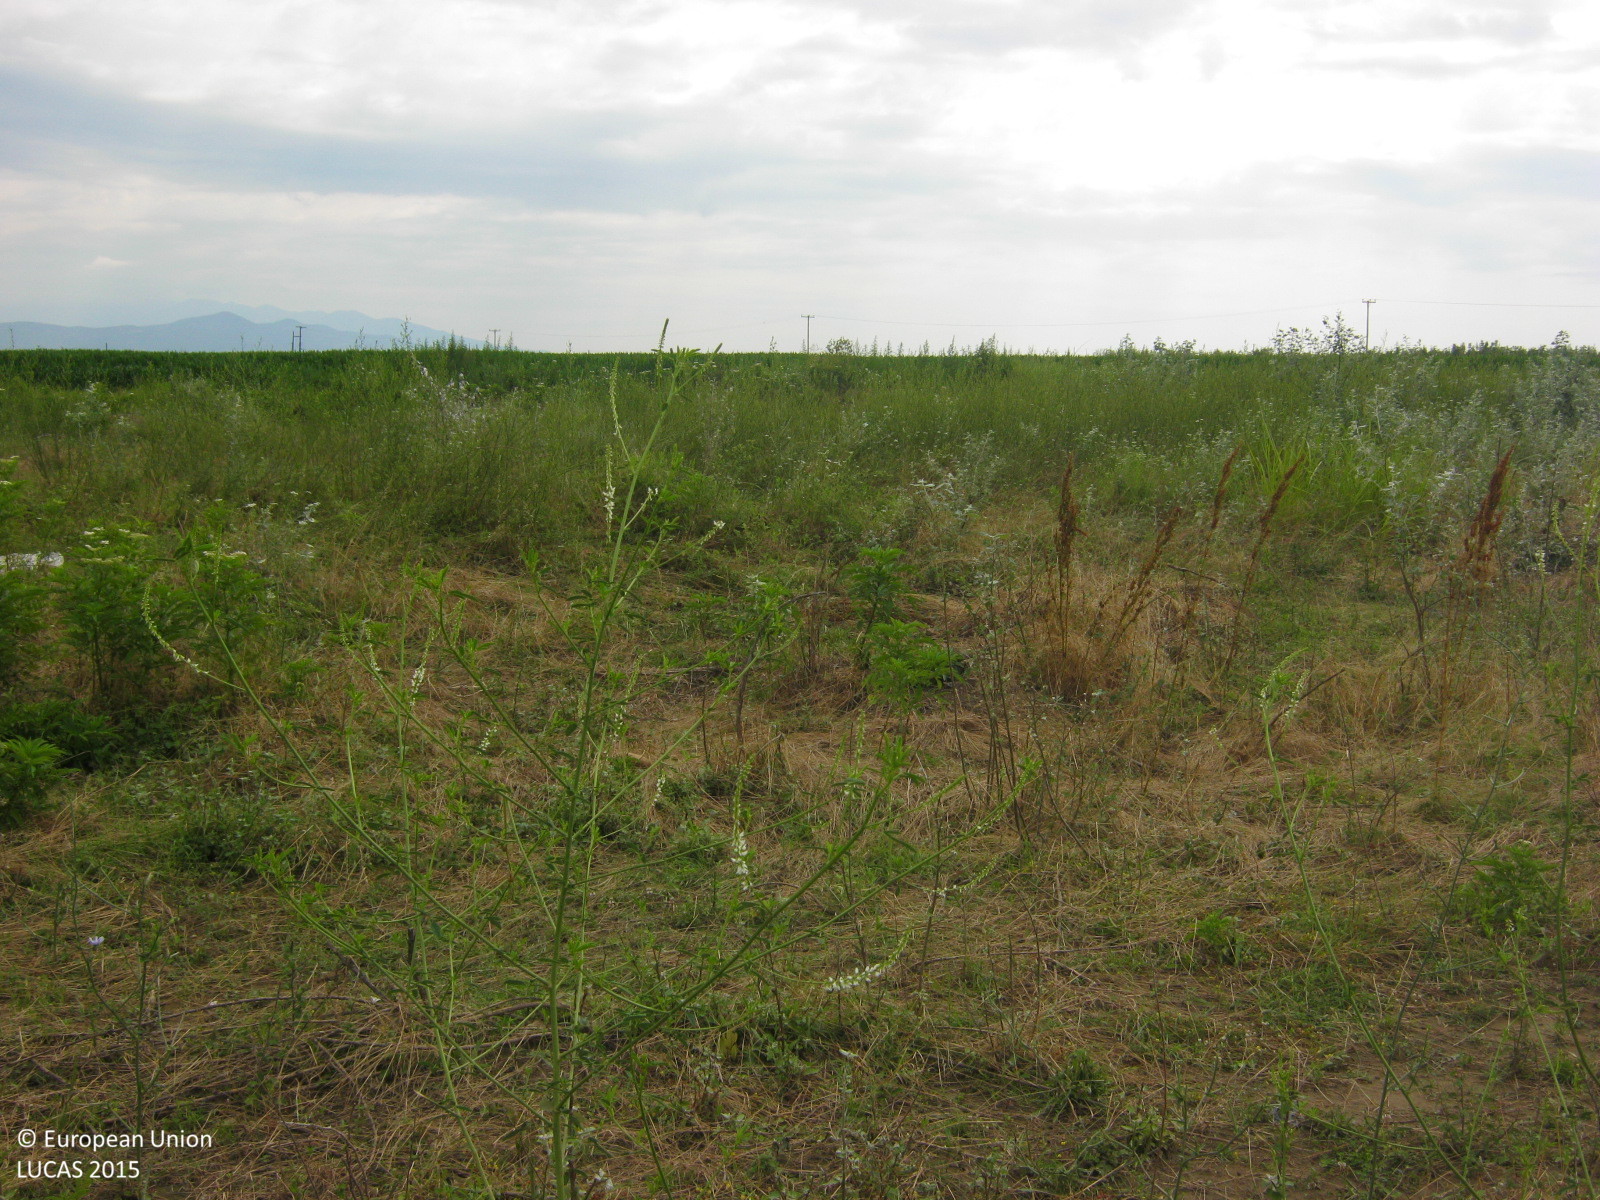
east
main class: Grassland
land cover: Spontaneously vegetated surfaces
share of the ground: > 75 %
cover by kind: herbaceous plants 100 %
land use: Abandoned areas
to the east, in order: Spontaneously vegetated surfaces; Maize; Electric lines; Maize
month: June
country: GR
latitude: 41.0743
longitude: 24.9790
